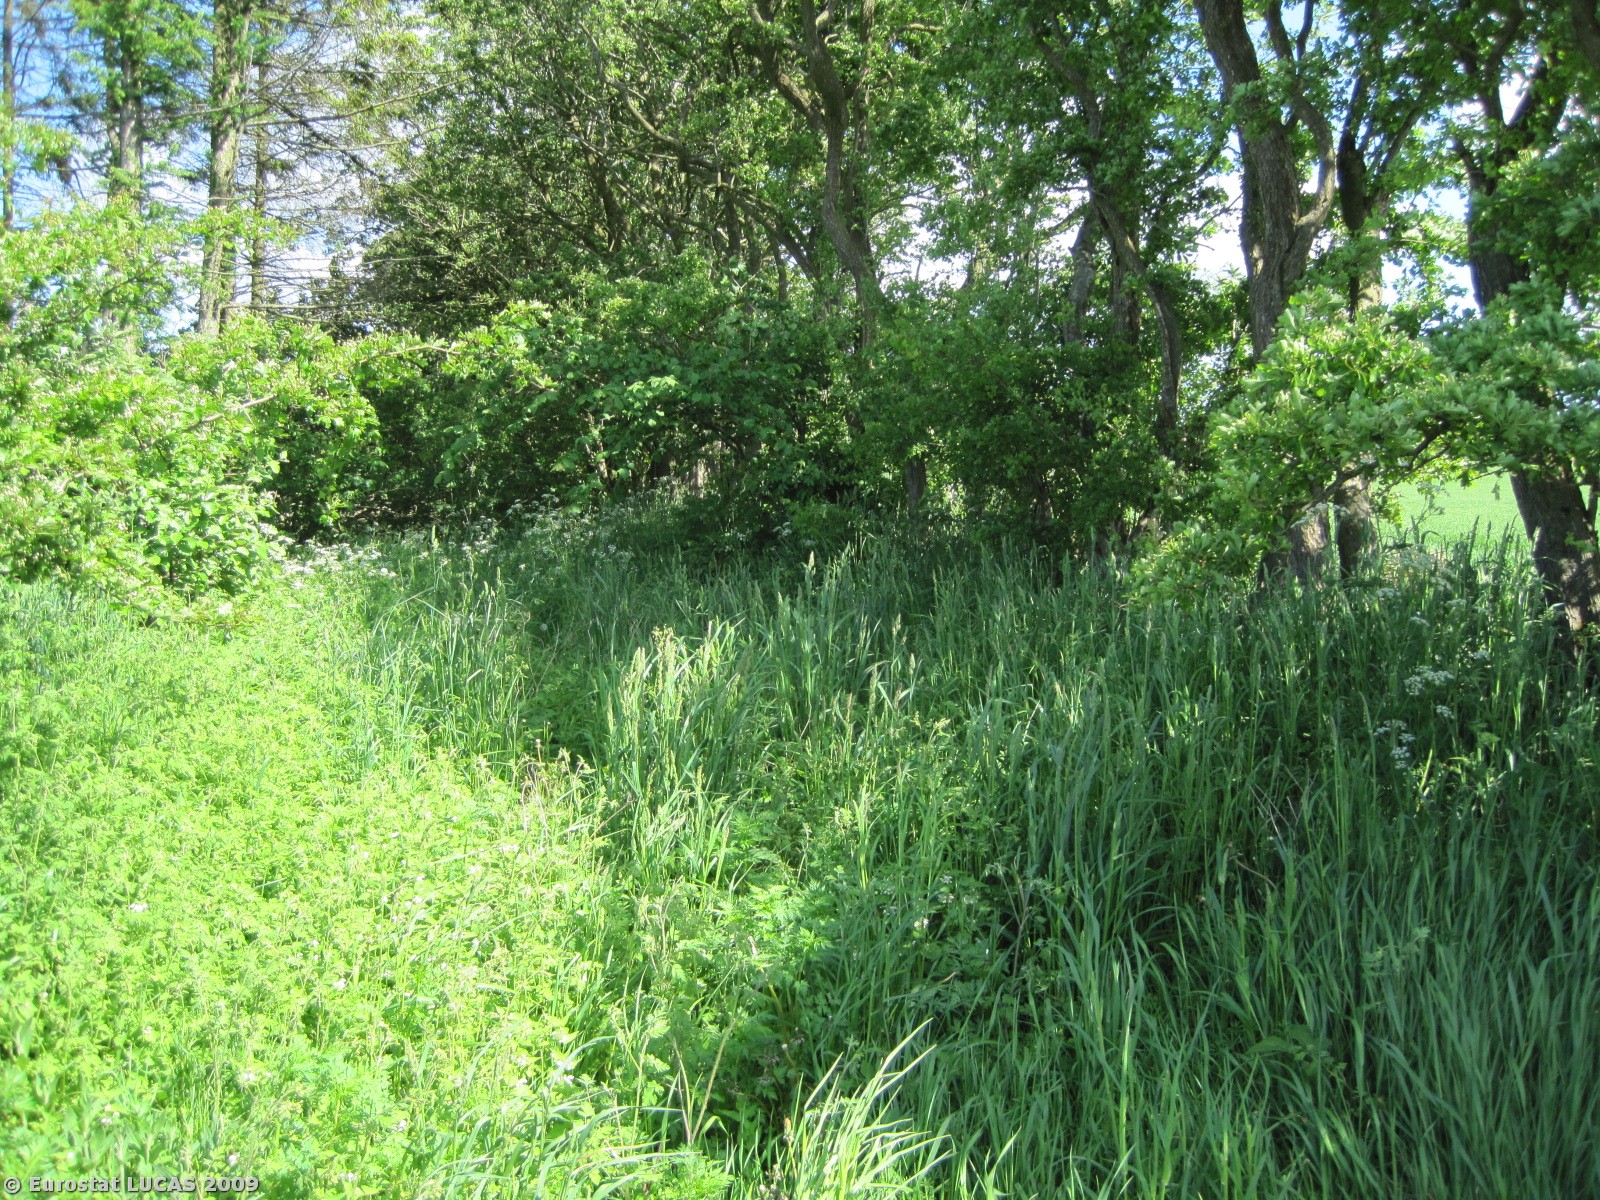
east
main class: Cropland
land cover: Maize
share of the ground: 10 - 25 %
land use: Agriculture (excluding fallow land and kitchen gardens)
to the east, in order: Maize; Grass margins; Broadleaved woodland; Barley
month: May
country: DK
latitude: 56.8349
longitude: 10.0491
